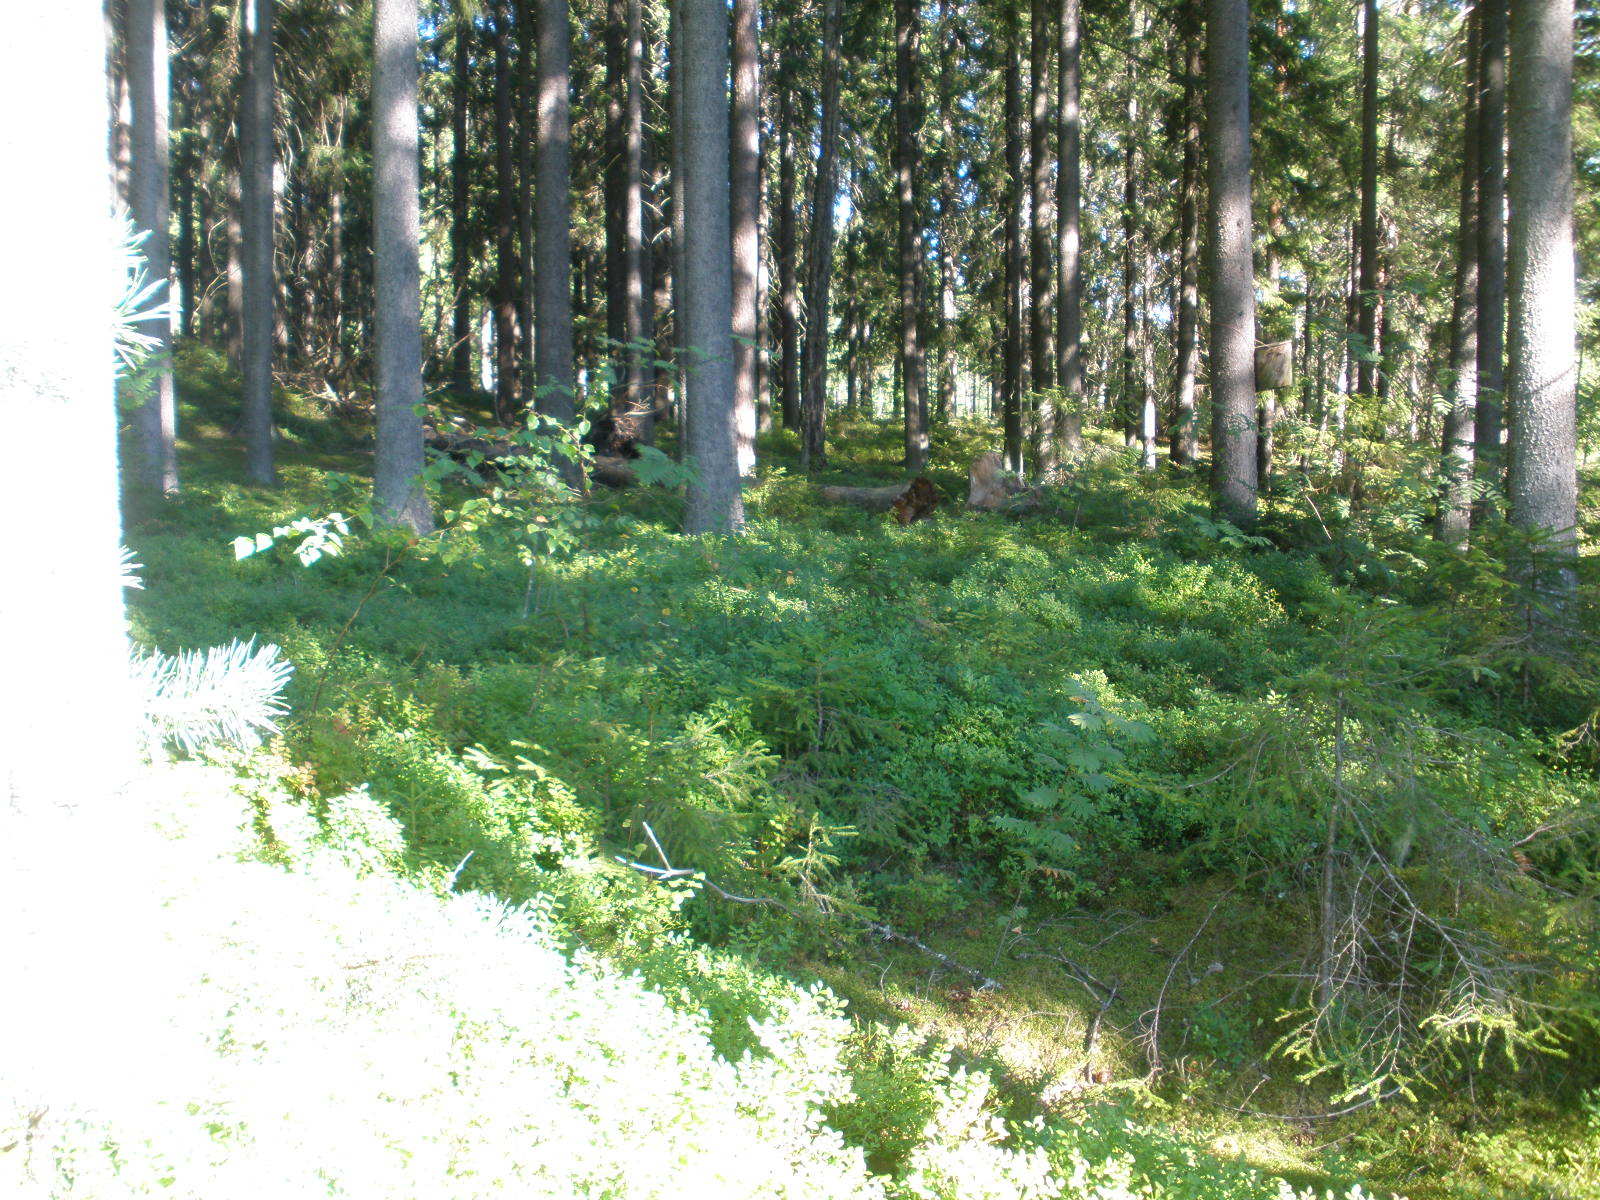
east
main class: Woodland
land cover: Spruce dominated coniferous woodland
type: boreal forest
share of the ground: > 75 %
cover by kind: coniferous forest trees 75 %, herbaceous plants 15 %, shrubs 5 %, lichens and mosses 5 %
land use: Forestry
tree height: > 5 m
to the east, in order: Spruce dominated coniferous woodland; Artificial constructions in urban areas; Spruce dominated mixed woodland; Artificial constructions in urban areas; Spruce dominated mixed woodland; Other mixed woodland
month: August
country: FI
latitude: 60.5650
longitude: 23.9402
